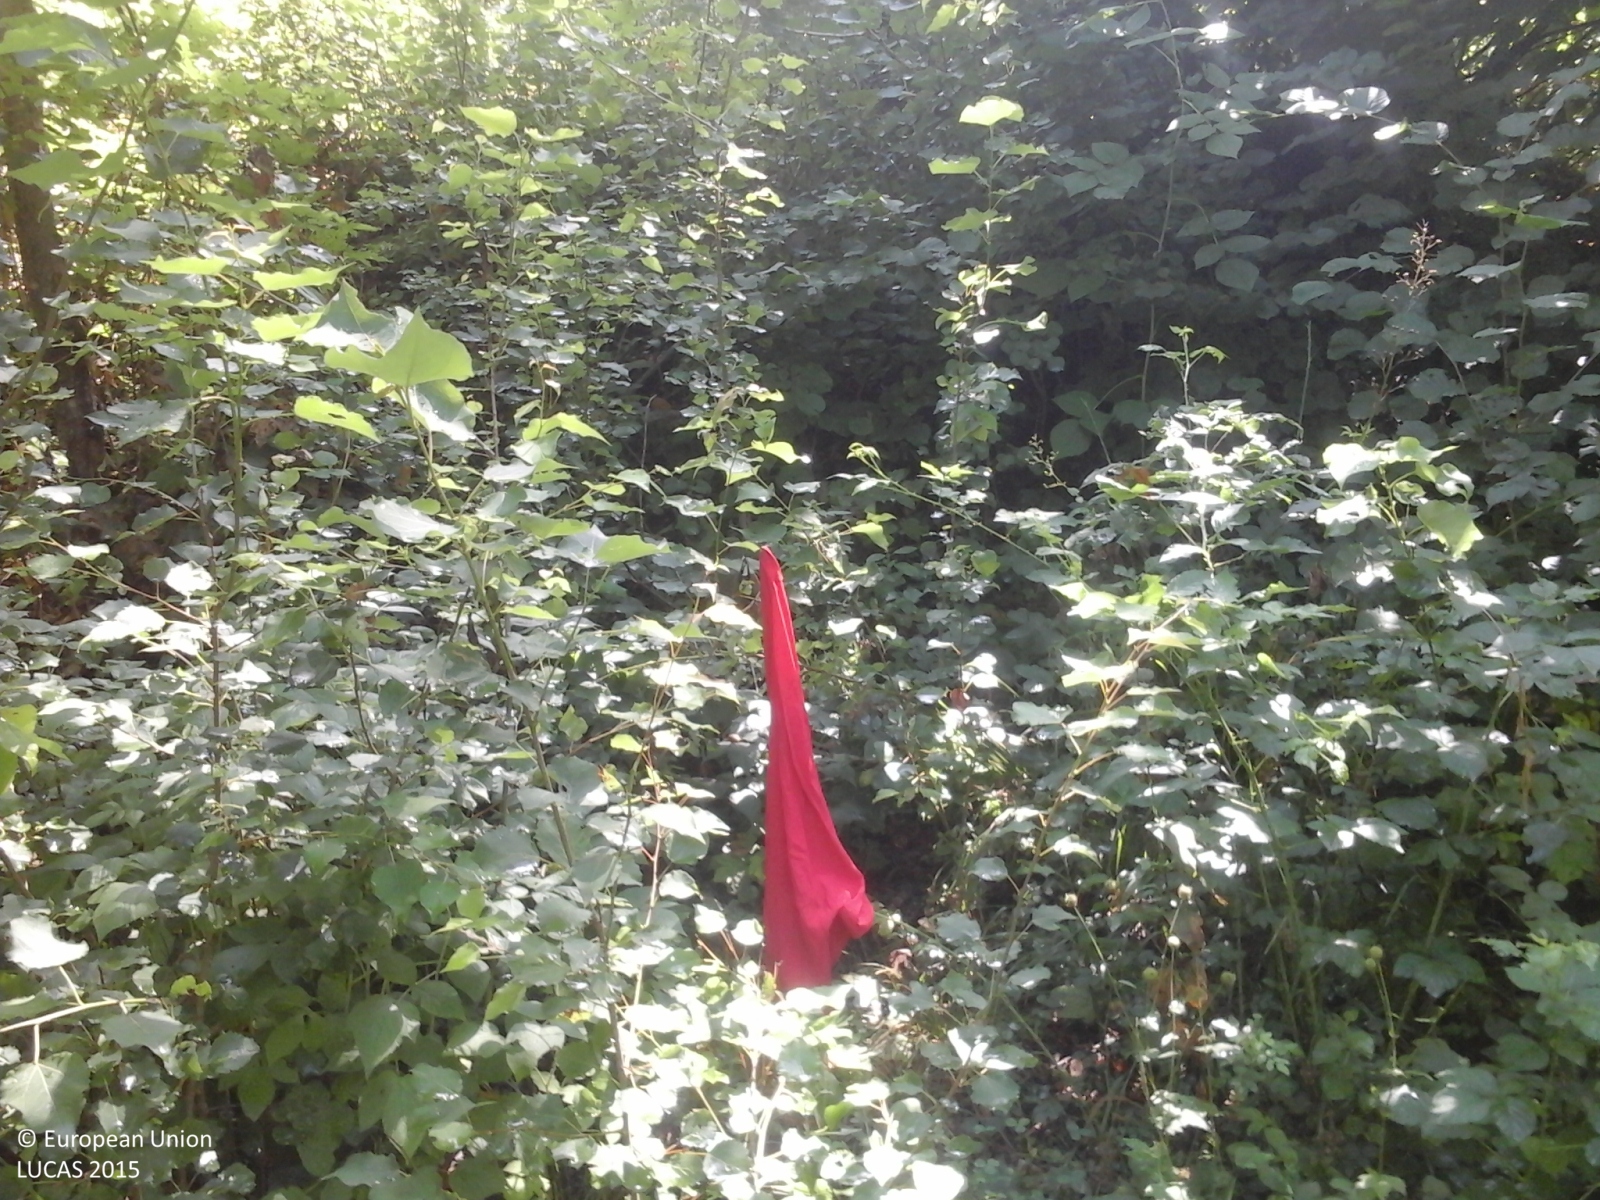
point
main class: Woodland
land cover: Broadleaved woodland
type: mesophytic deciduous forest
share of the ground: > 75 %
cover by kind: broadleaved forest trees 100 %
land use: Forestry
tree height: > 5 m
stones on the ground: 10 - 25 %
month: August
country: IT
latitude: 45.8990
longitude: 9.3694
